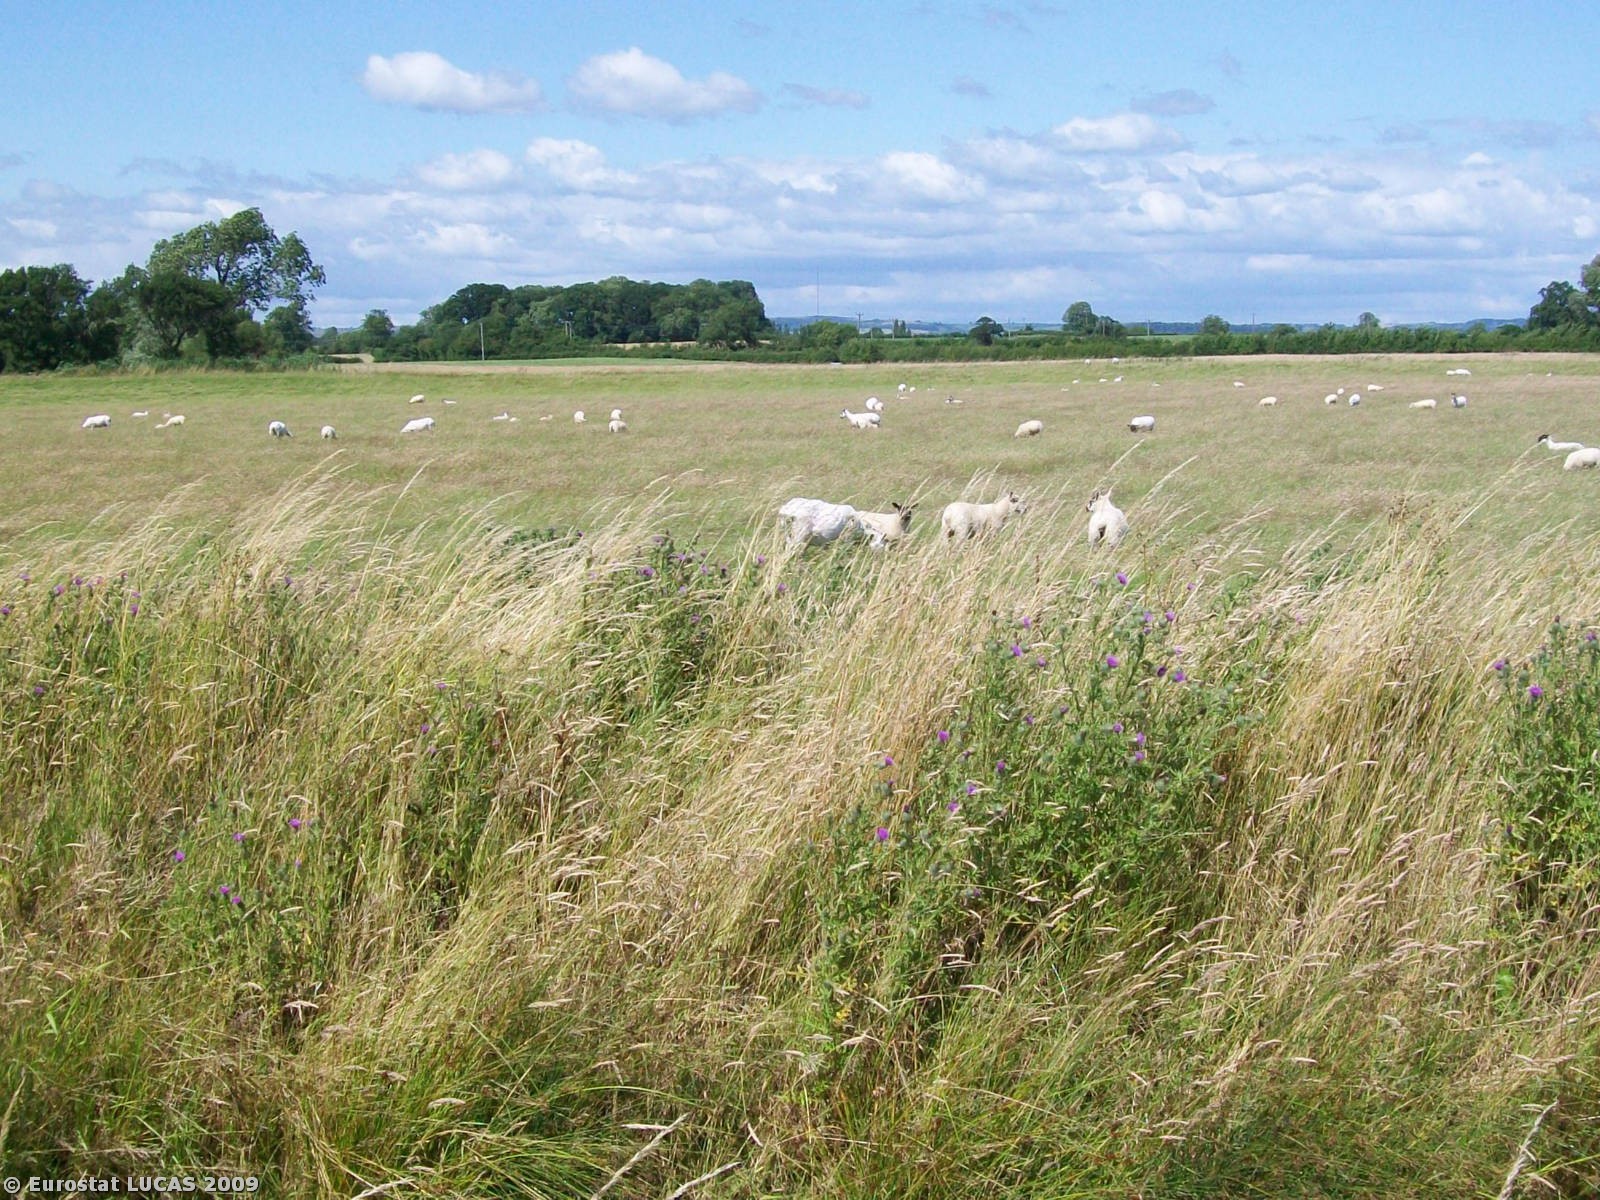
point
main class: Grassland
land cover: Grassland without tree/shrub cover
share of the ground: > 75 %
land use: Agriculture (excluding fallow land and kitchen gardens)
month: July
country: GB
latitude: 51.1288
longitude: -2.6870
